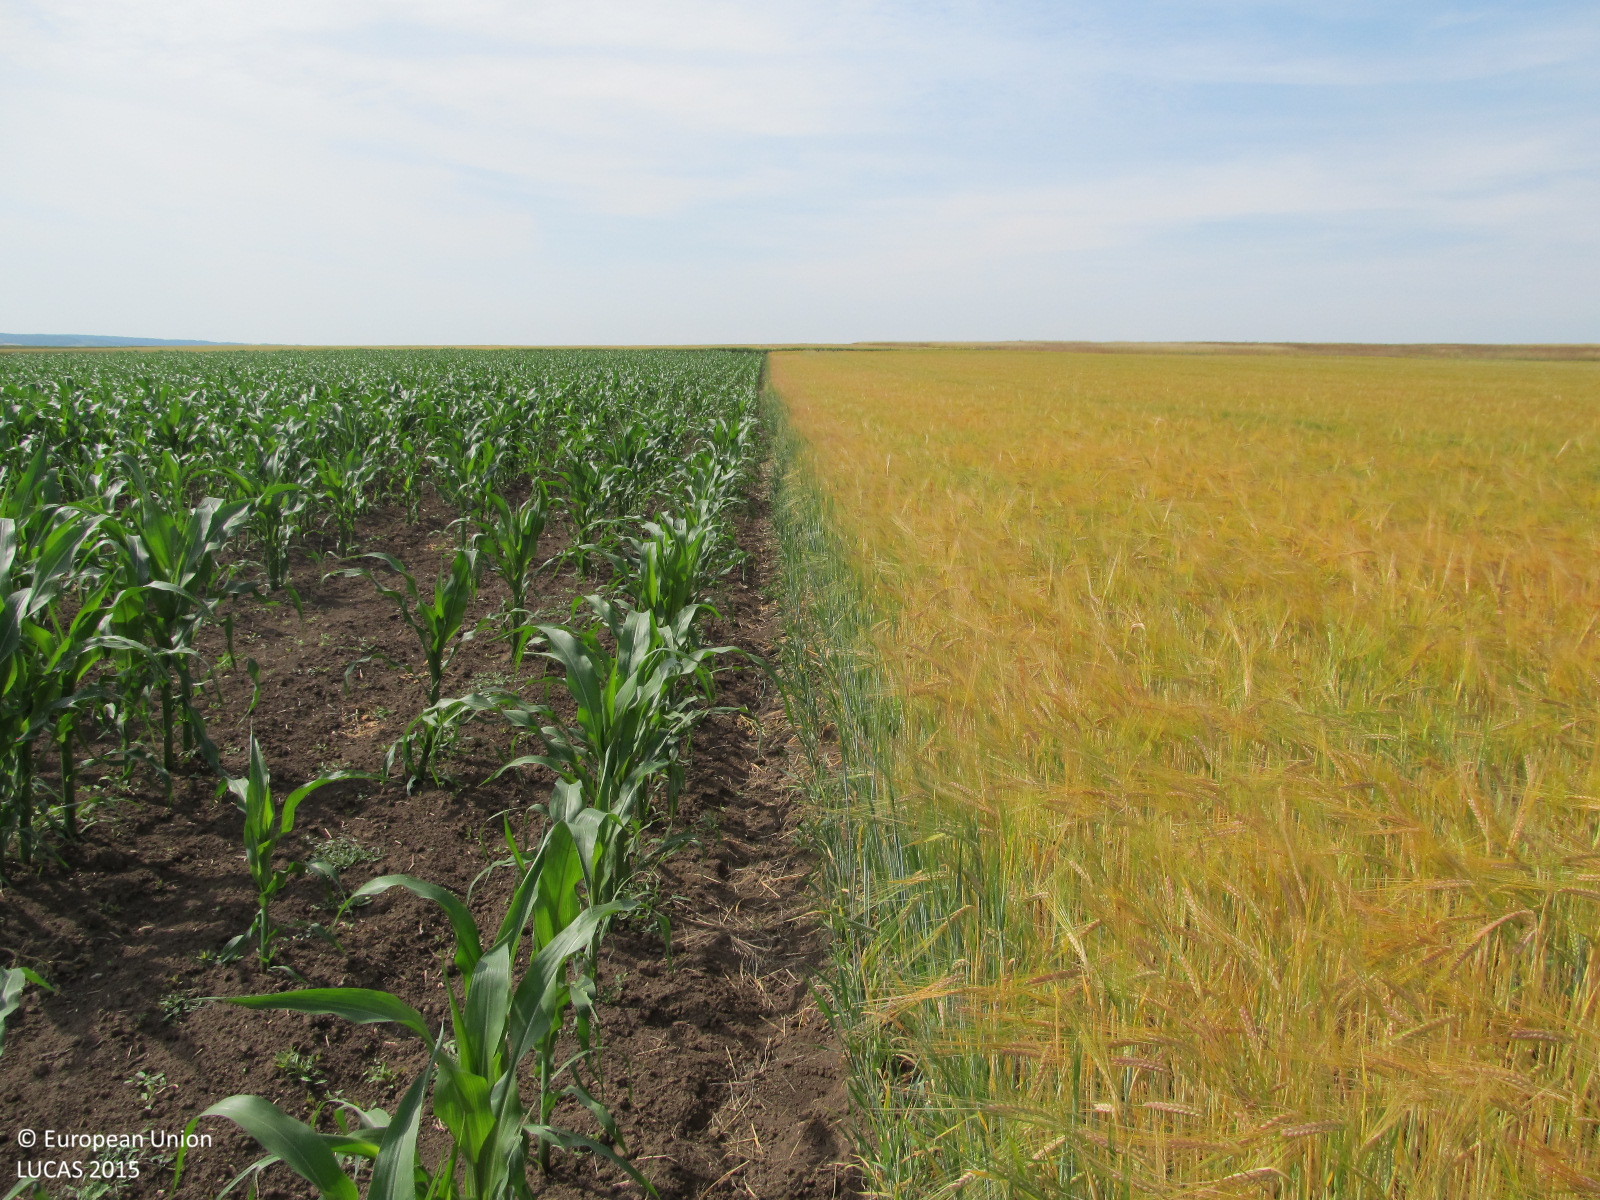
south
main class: Cropland
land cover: Barley
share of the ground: > 75 %
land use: Agriculture (excluding fallow land and kitchen gardens)
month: June
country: AT
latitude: 48.6424
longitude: 15.9079
